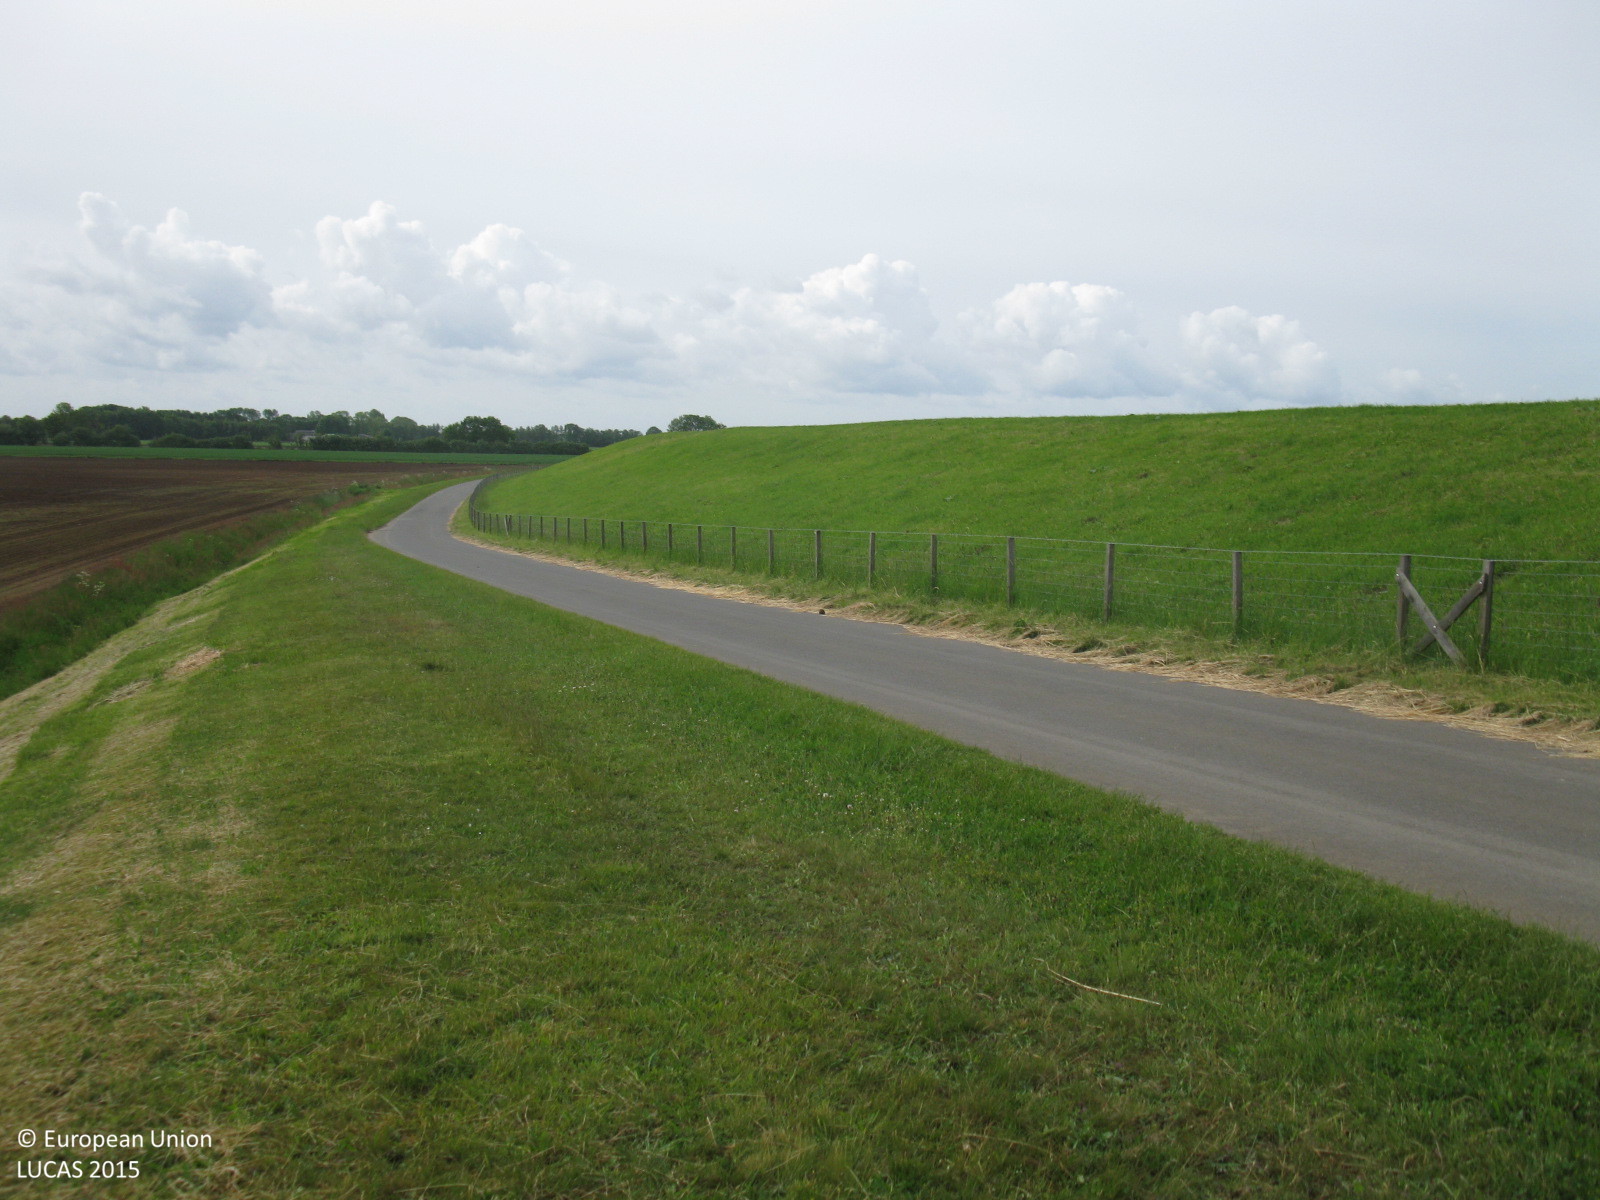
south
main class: Grassland
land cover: Grassland without tree/shrub cover
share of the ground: > 75 %
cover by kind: herbaceous plants 100 %
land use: Protection infrastructures
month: June
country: DE
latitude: 53.0841
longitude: 7.2982
